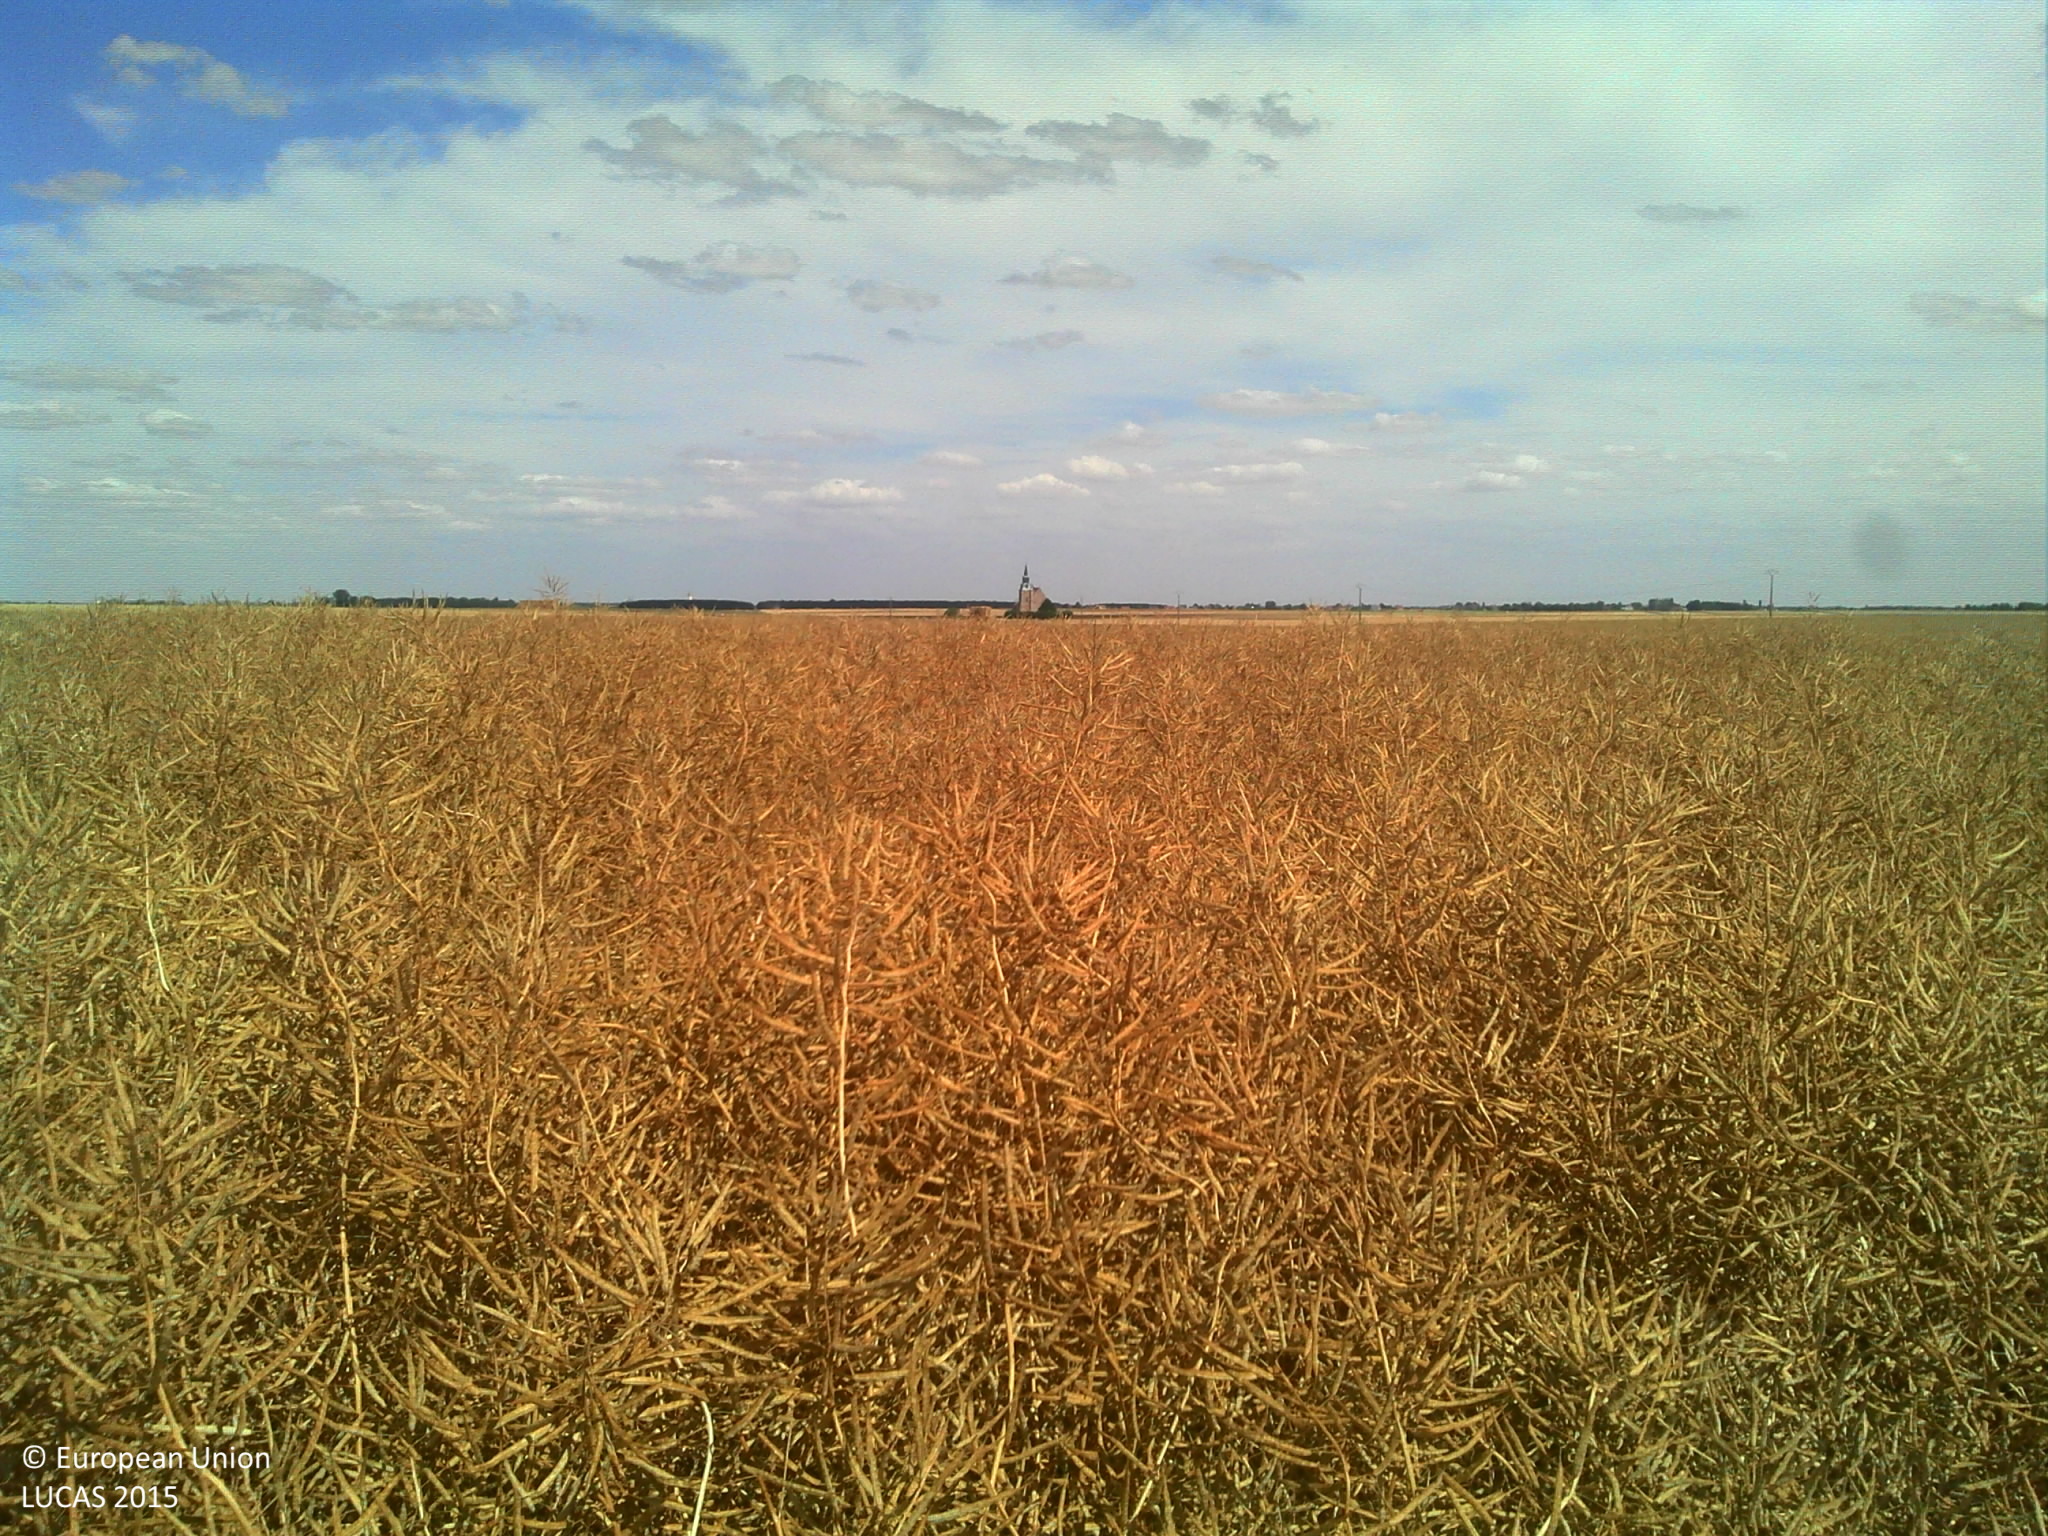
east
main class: Cropland
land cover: Rape and turnip rape
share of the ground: > 75 %
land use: Agriculture (excluding fallow land and kitchen gardens)
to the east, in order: Rape and turnip rape
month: July
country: FR
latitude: 48.4015
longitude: 1.2694
